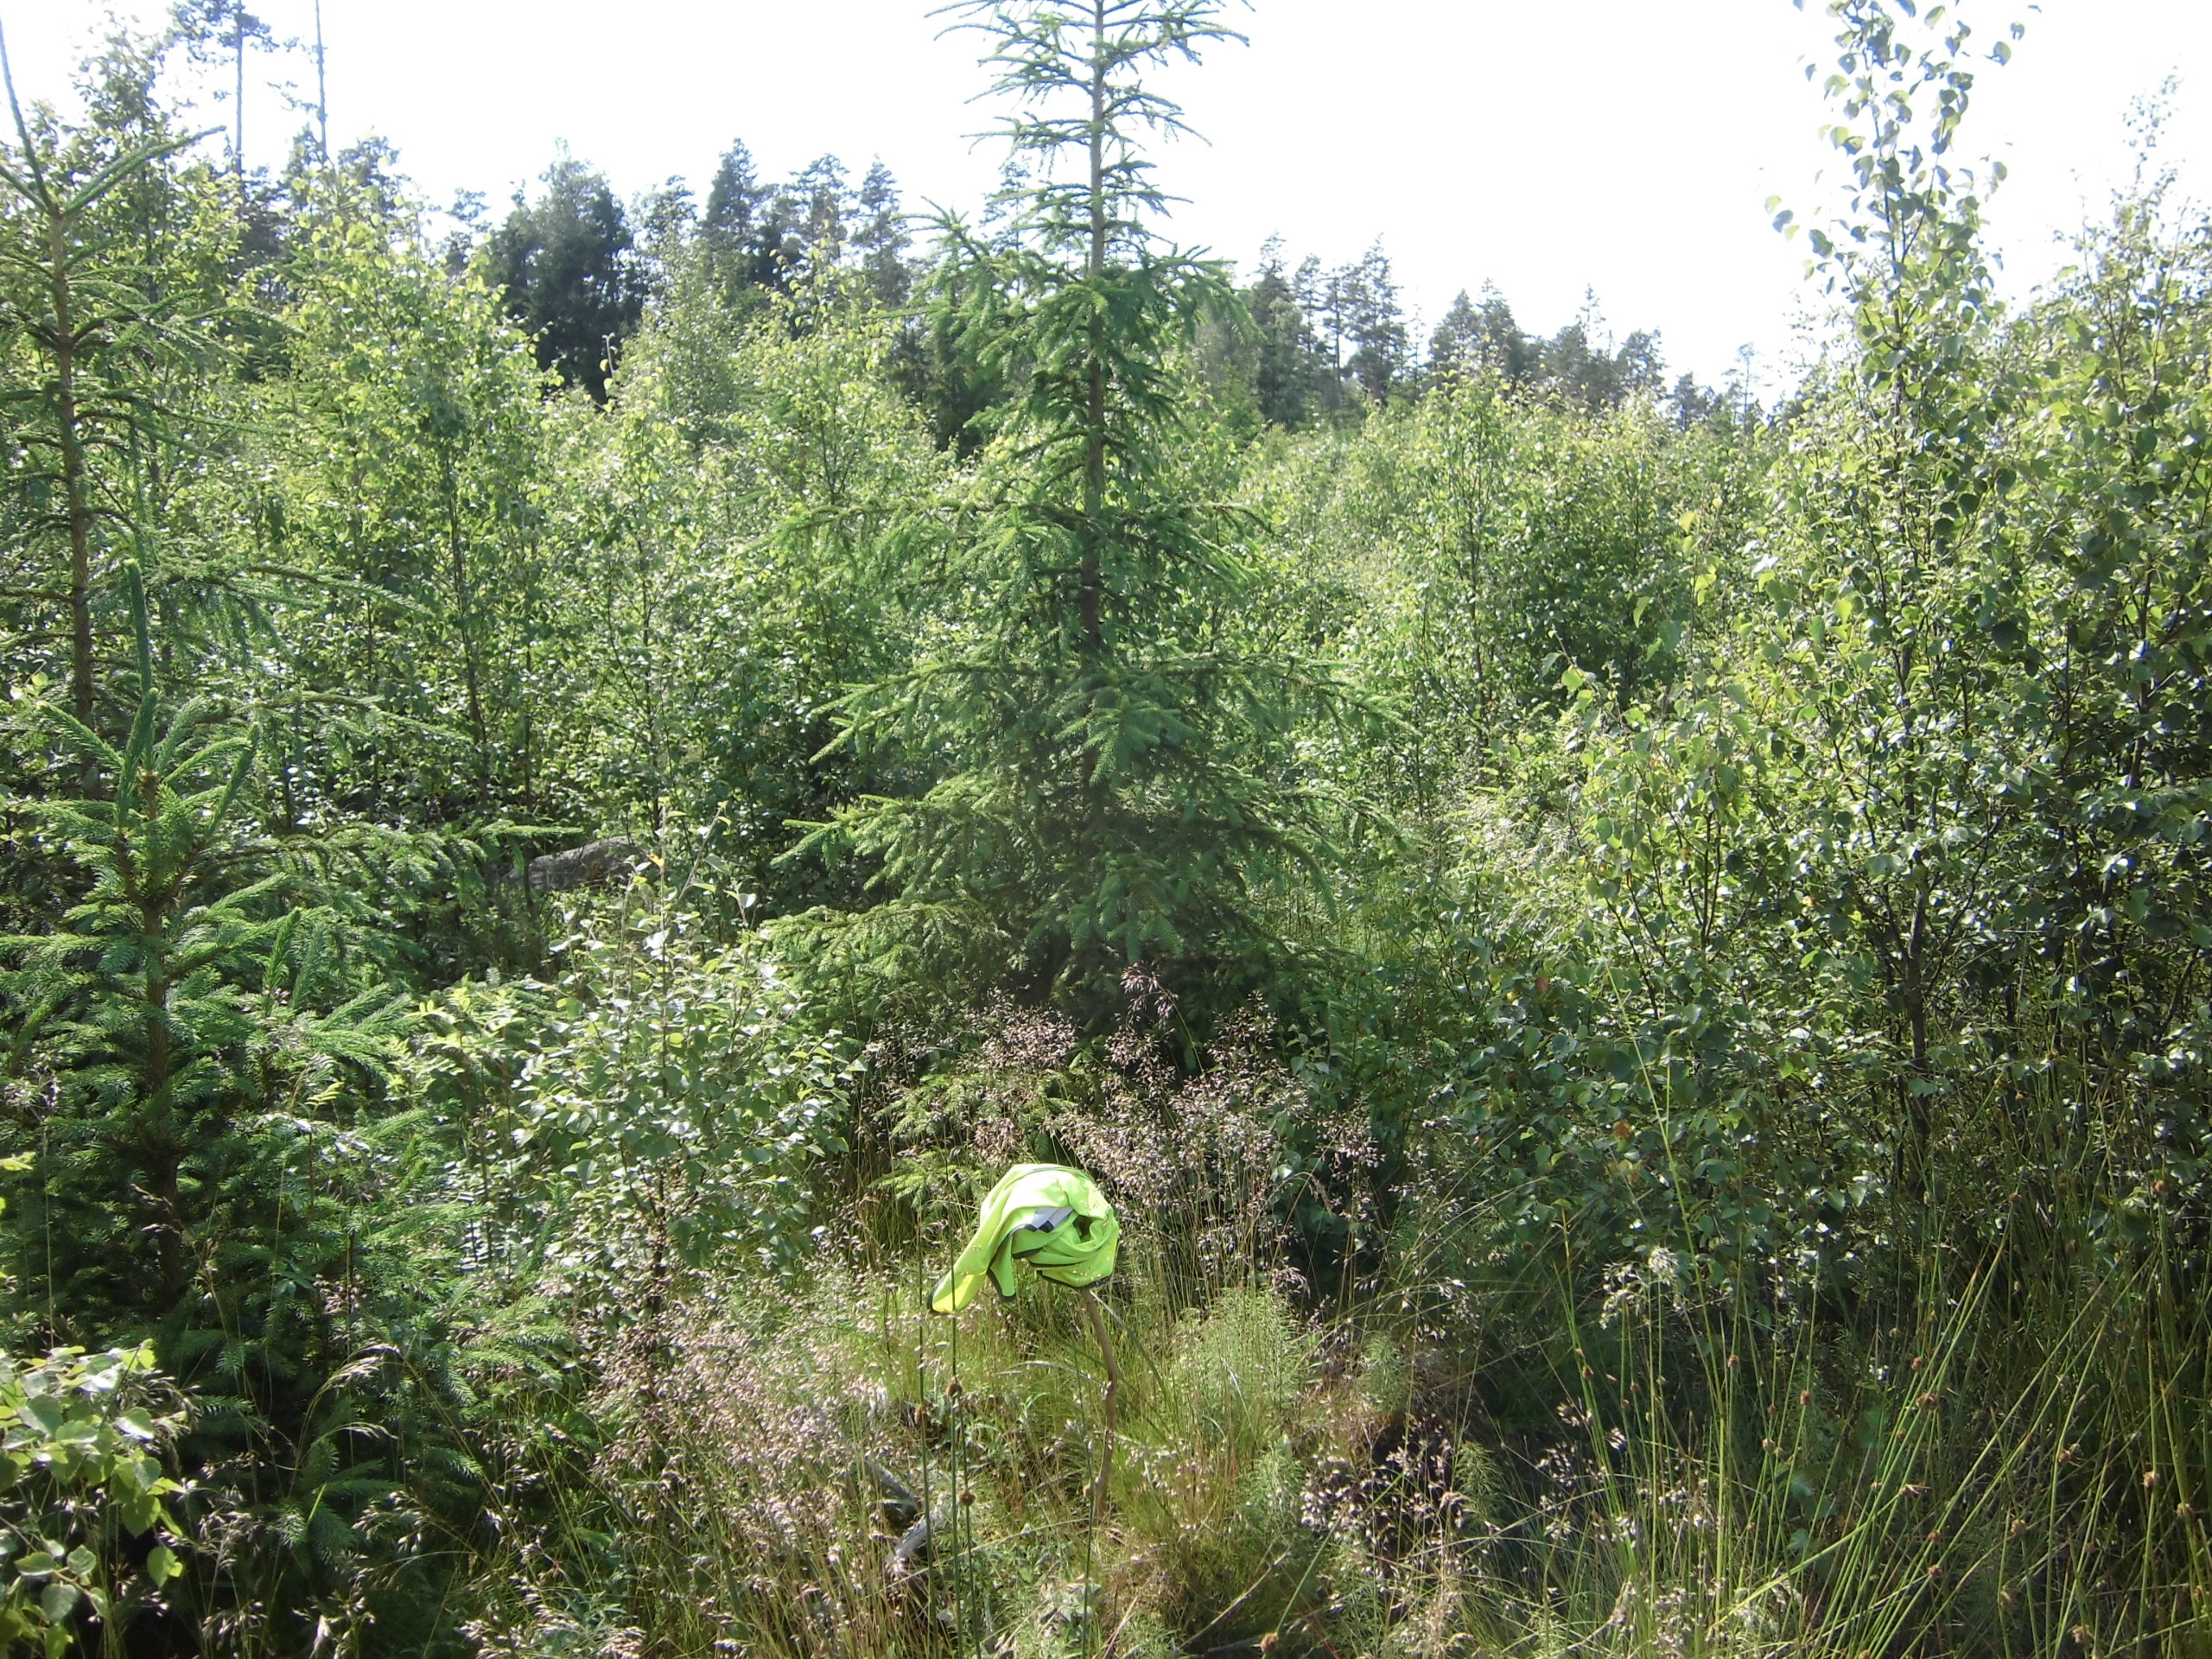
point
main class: Woodland
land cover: Spruce dominated mixed woodland
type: boreal forest
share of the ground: > 75 %
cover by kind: broadleaved forest trees 45 %, coniferous forest trees 30 %, herbaceous plants 15 %, shrubs 5 %, lichens and mosses 5 %
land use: Forestry
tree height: < 5 m
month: July
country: SE
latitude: 57.3493
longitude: 14.5662
